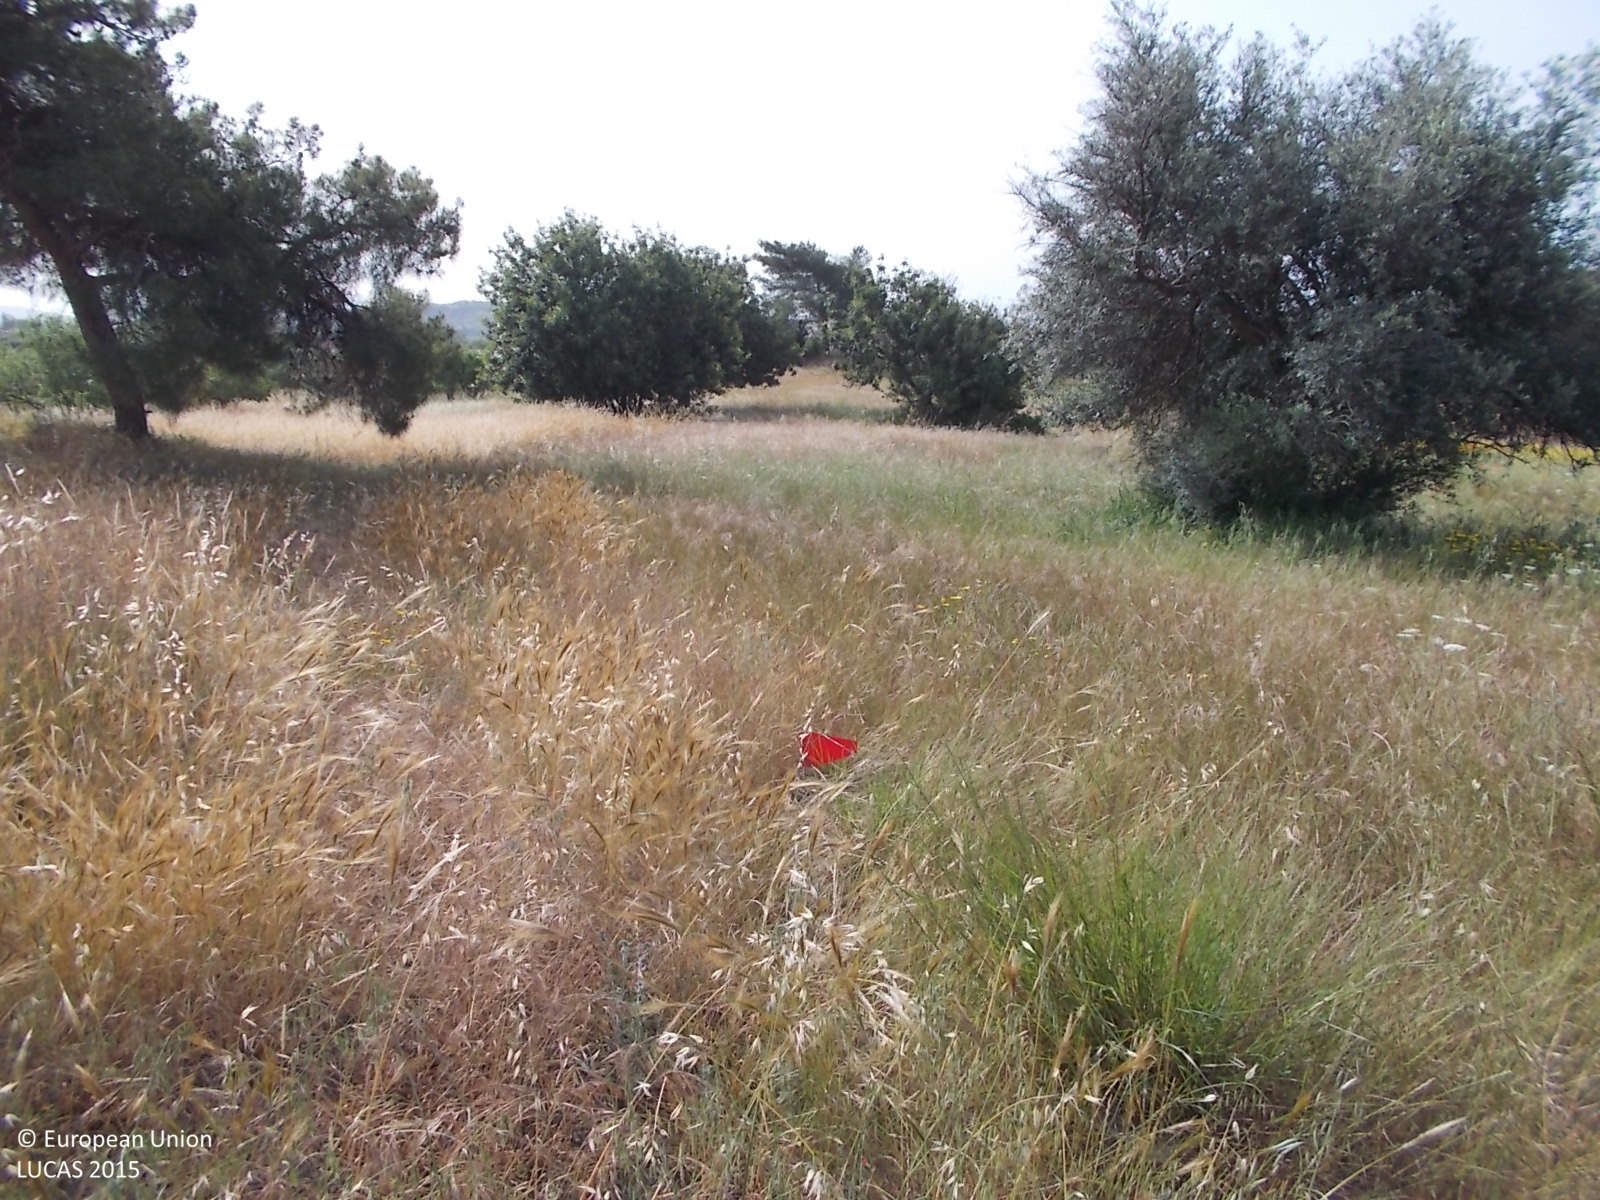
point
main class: Grassland
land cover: Spontaneously vegetated surfaces
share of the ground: > 75 %
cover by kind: herbaceous plants 100 %
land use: Fallow land
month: April
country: CY
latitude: 34.7566
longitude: 33.1456
